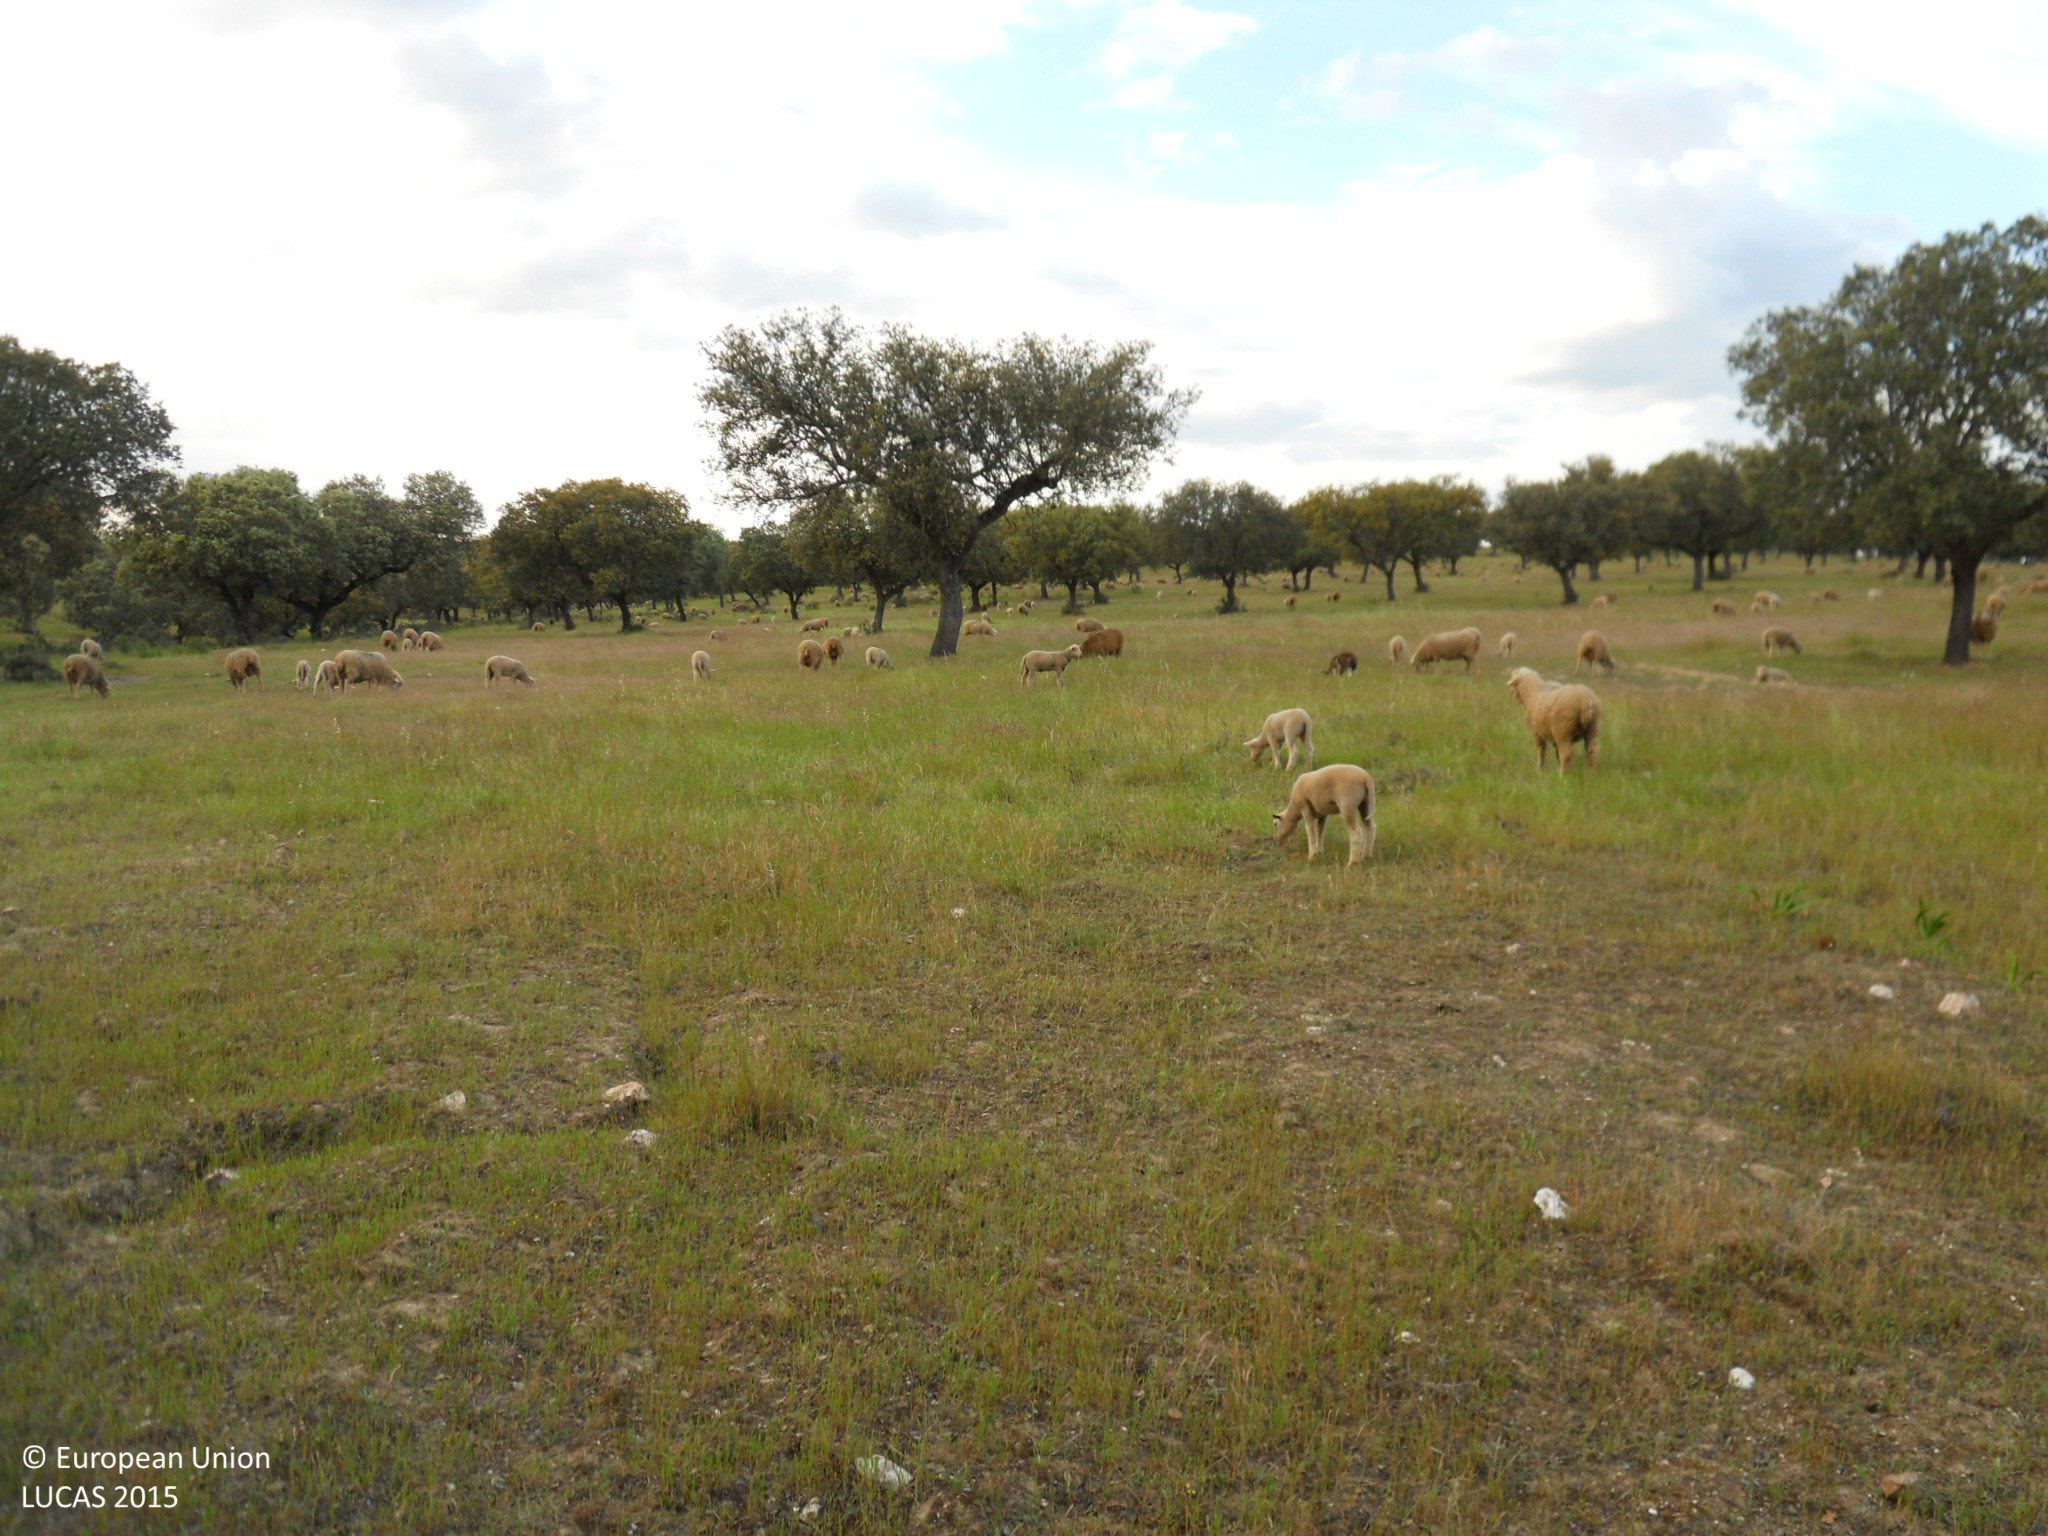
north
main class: Woodland
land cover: Broadleaved woodland
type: broadleaved evergreen forest
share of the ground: > 75 %
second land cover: Grassland without tree/shrub cover
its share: > 75 %
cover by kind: broadleaved forest trees 95 %, herbaceous plants 5 %
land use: Forestry
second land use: Agriculture (excluding fallow land and kitchen gardens)
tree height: > 5 m
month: April
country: ES
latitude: 39.2329
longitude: -6.7892
